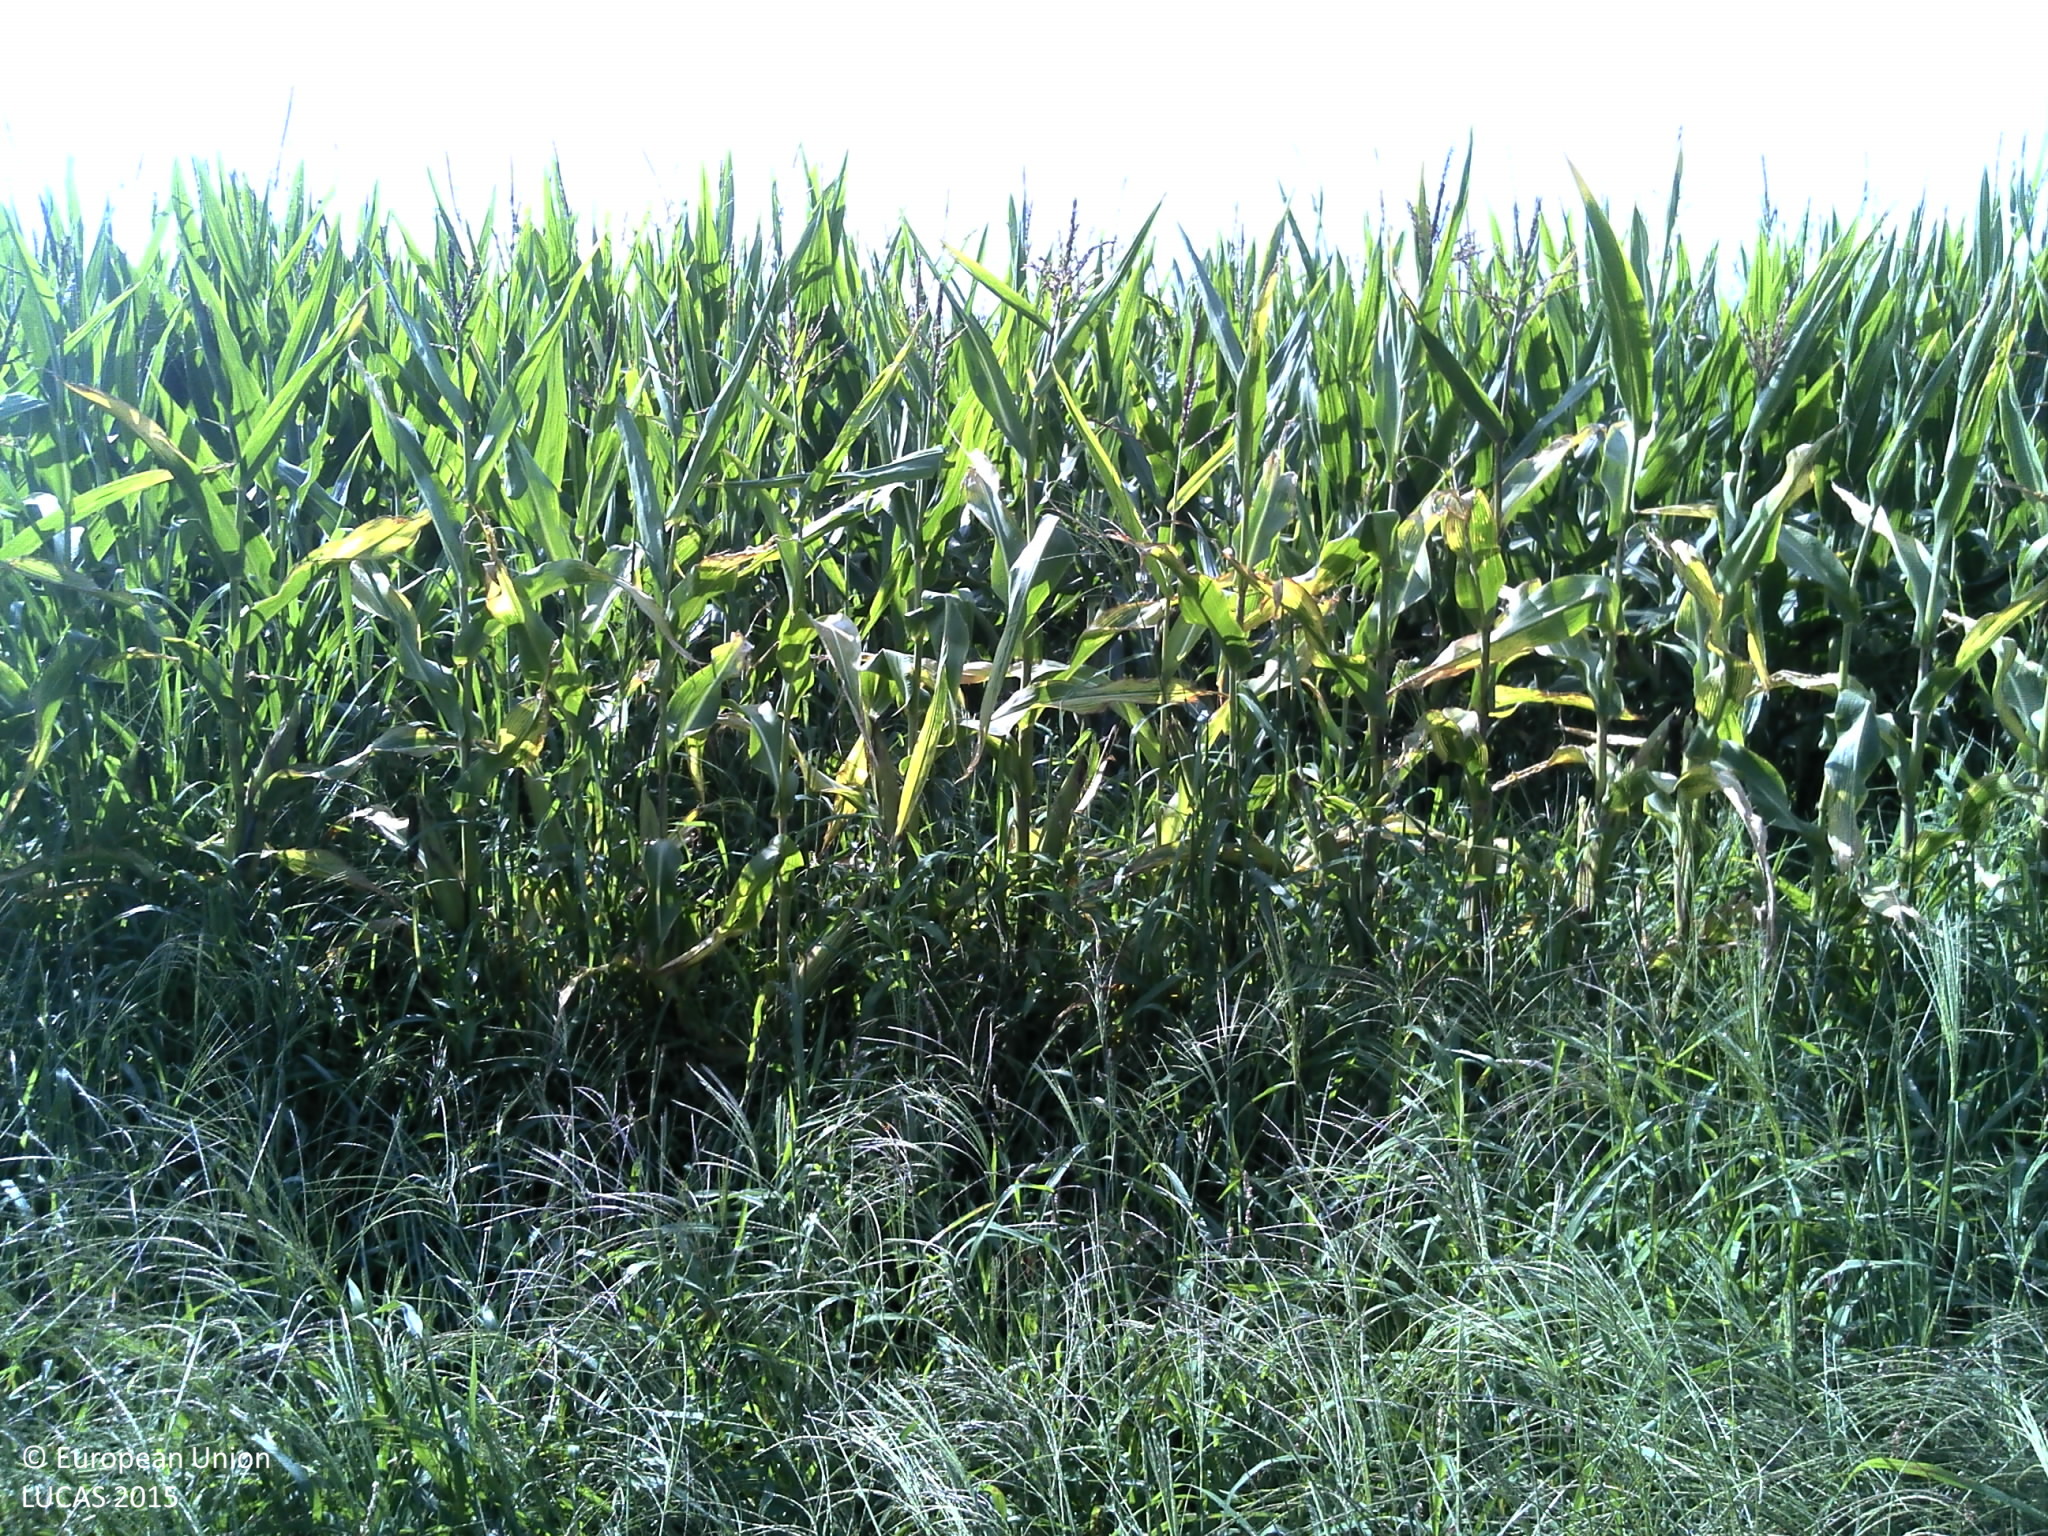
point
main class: Cropland
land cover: Maize
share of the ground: > 75 %
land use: Agriculture (excluding fallow land and kitchen gardens)
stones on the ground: < 10 %
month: August
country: FR
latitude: 44.3421
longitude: -0.5135
